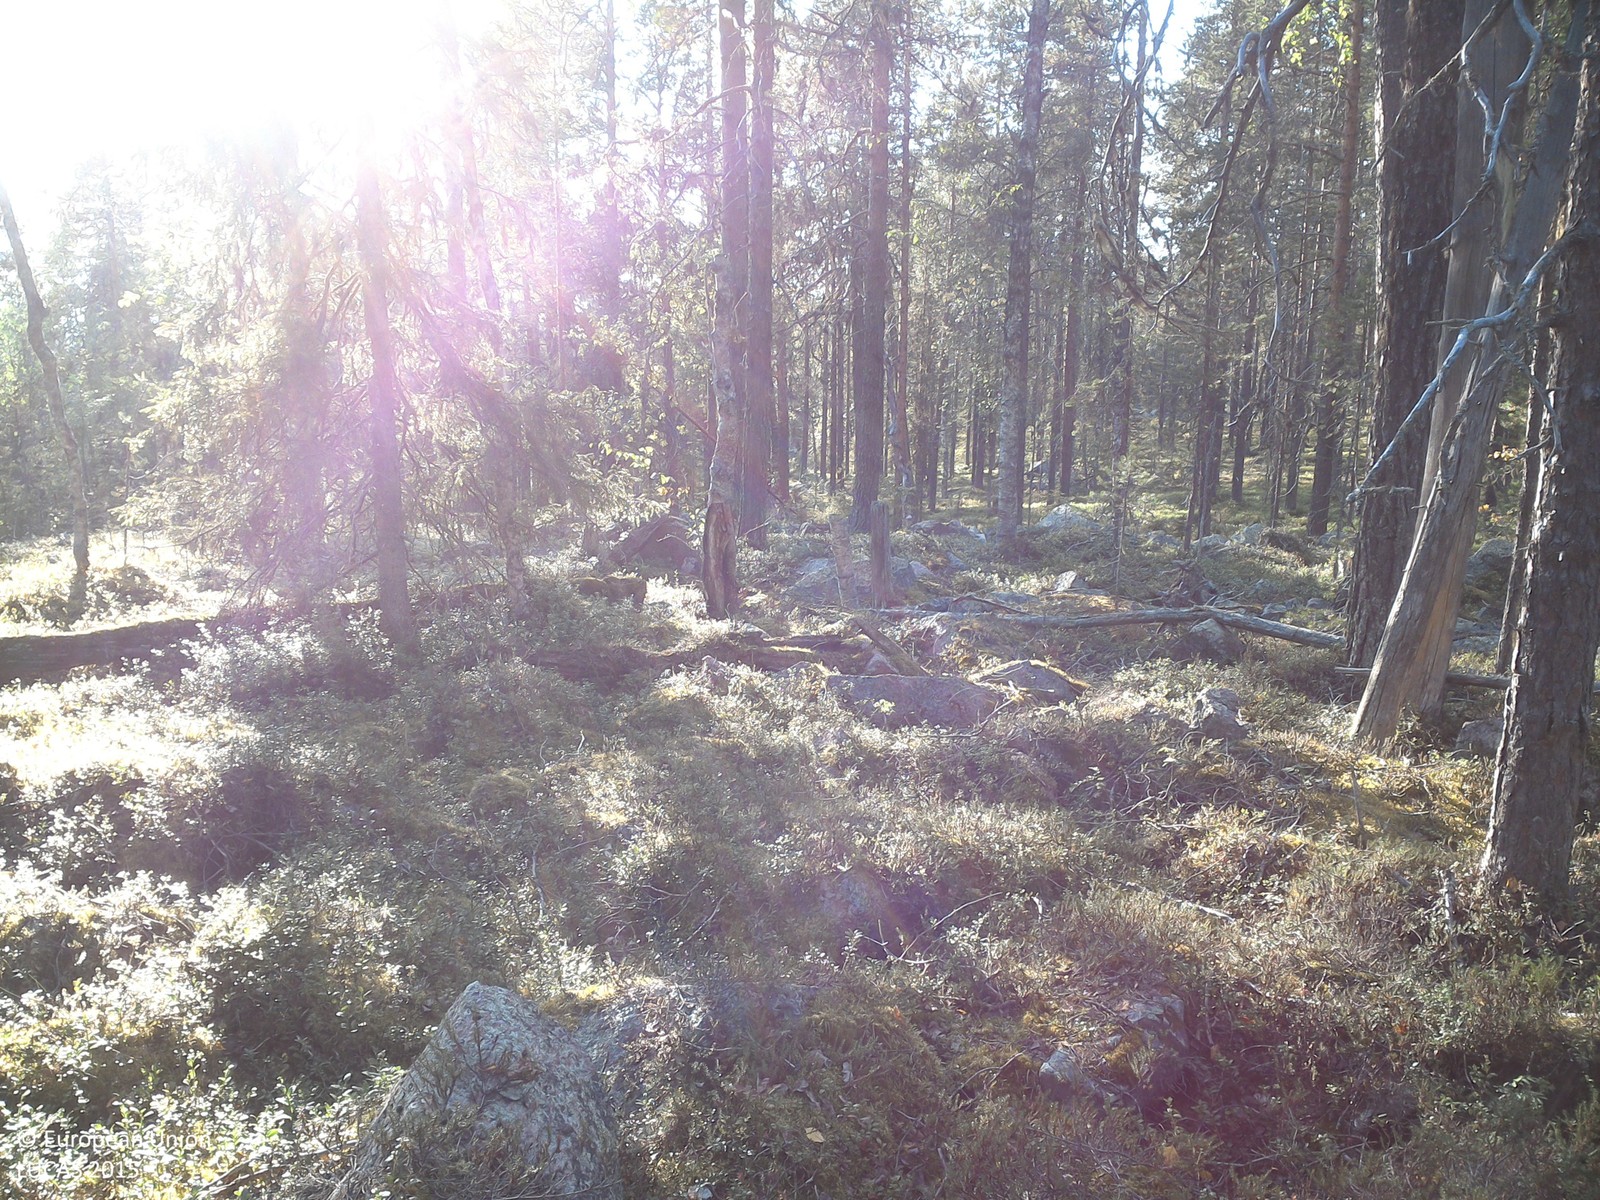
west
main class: Woodland
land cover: Pine dominated mixed woodland
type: boreal forest
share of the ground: 25 - 50 %
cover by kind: lichens and mosses 40 %, coniferous forest trees 25 %, shrubs 15 %, broadleaved forest trees 10 %, unconsolidated bare surface 10 %
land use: Forestry
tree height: > 5 m
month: August
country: SE
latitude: 67.1523
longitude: 22.4946
